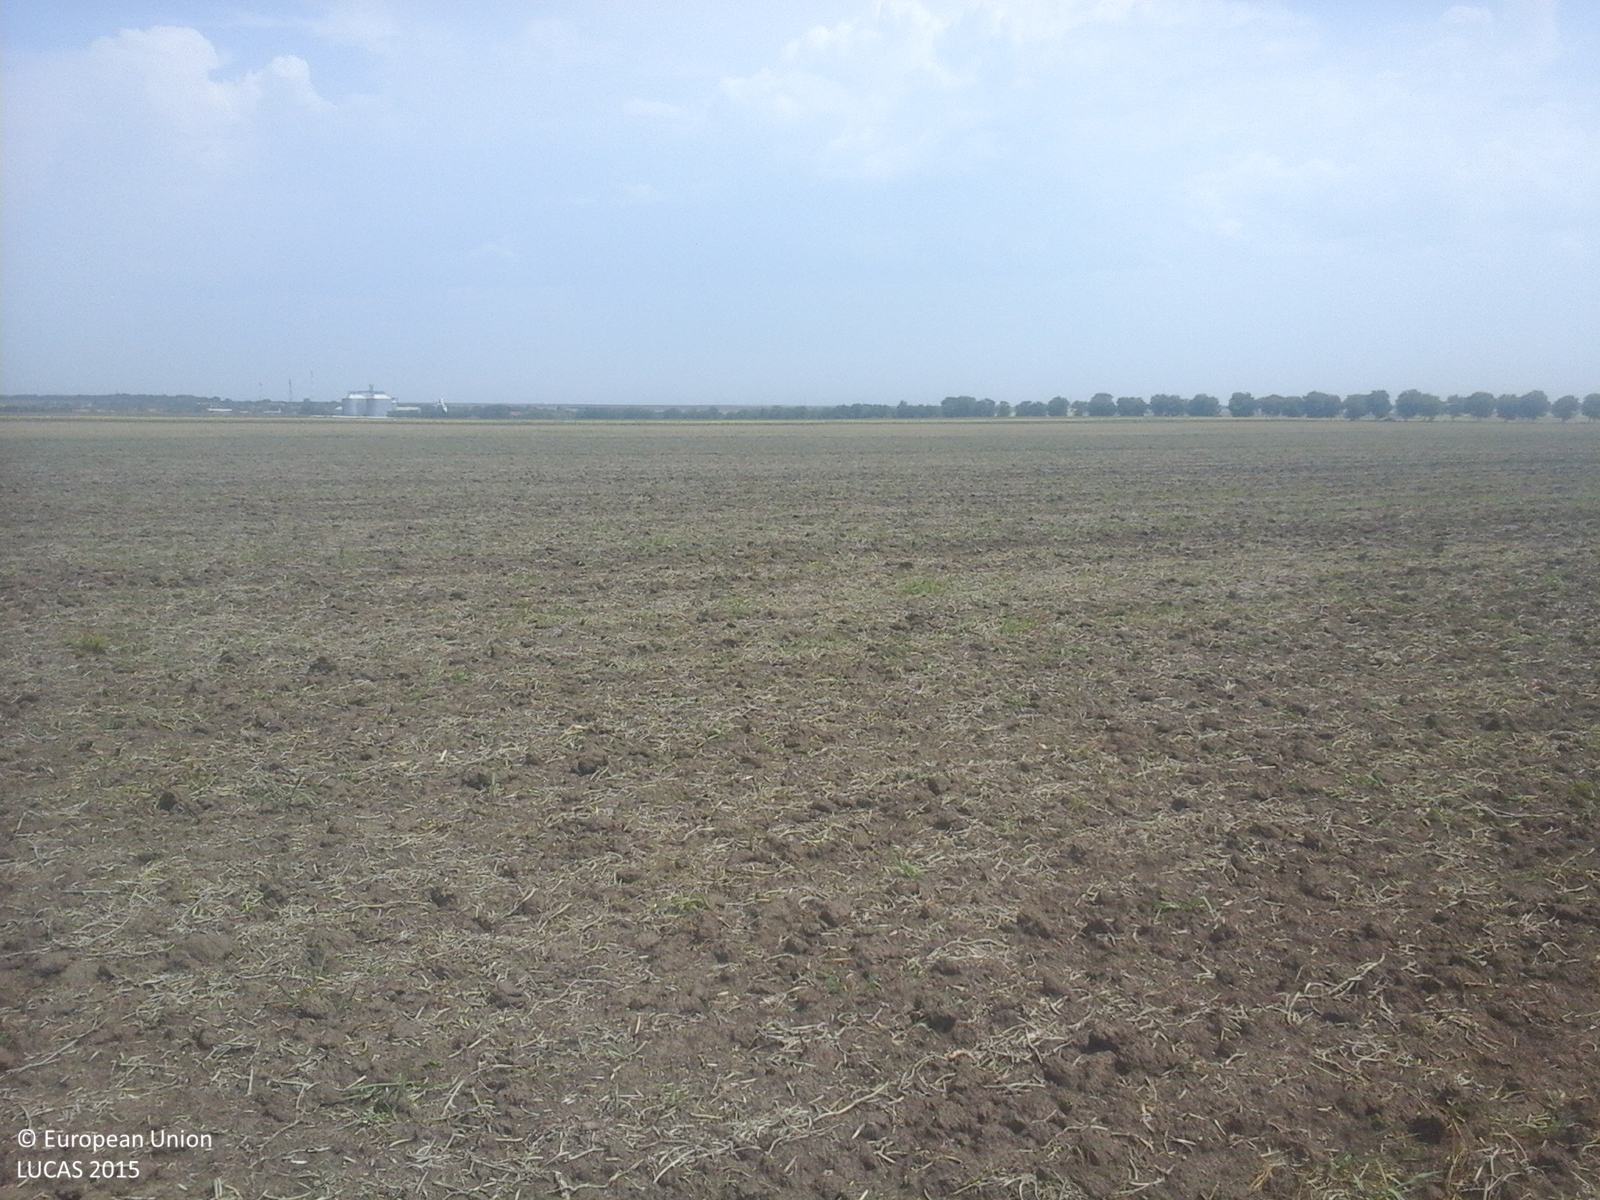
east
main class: Cropland
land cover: Soya
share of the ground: < 10 %
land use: Agriculture (excluding fallow land and kitchen gardens)
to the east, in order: Soya; Common wheat
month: August
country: RO
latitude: 43.8882
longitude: 28.2956
